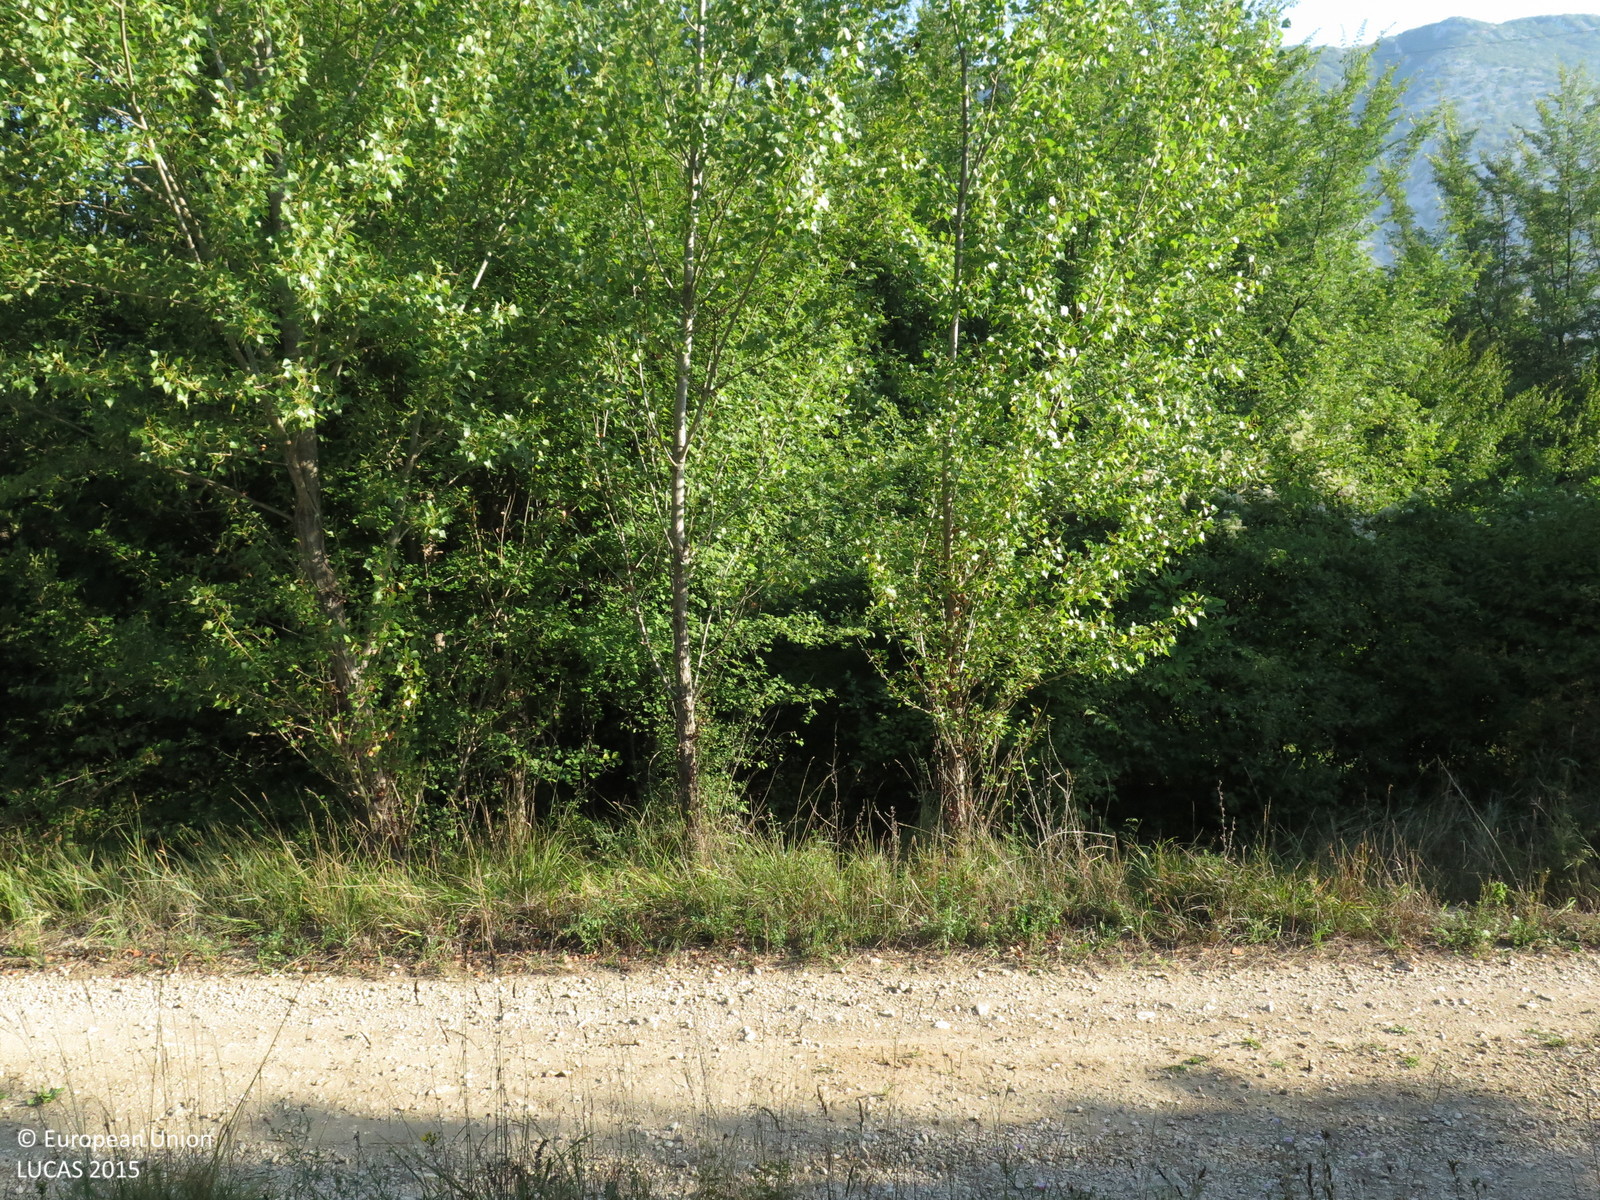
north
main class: Grassland
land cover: Grassland with sparse tree/shrub cover
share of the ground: > 75 %
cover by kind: herbaceous plants 85 %, shrubs 10 %, broadleaved forest trees 5 %
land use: Protection infrastructures
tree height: < 5 m
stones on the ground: 10 - 25 %
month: August
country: HR
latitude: 45.2207
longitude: 14.6685
